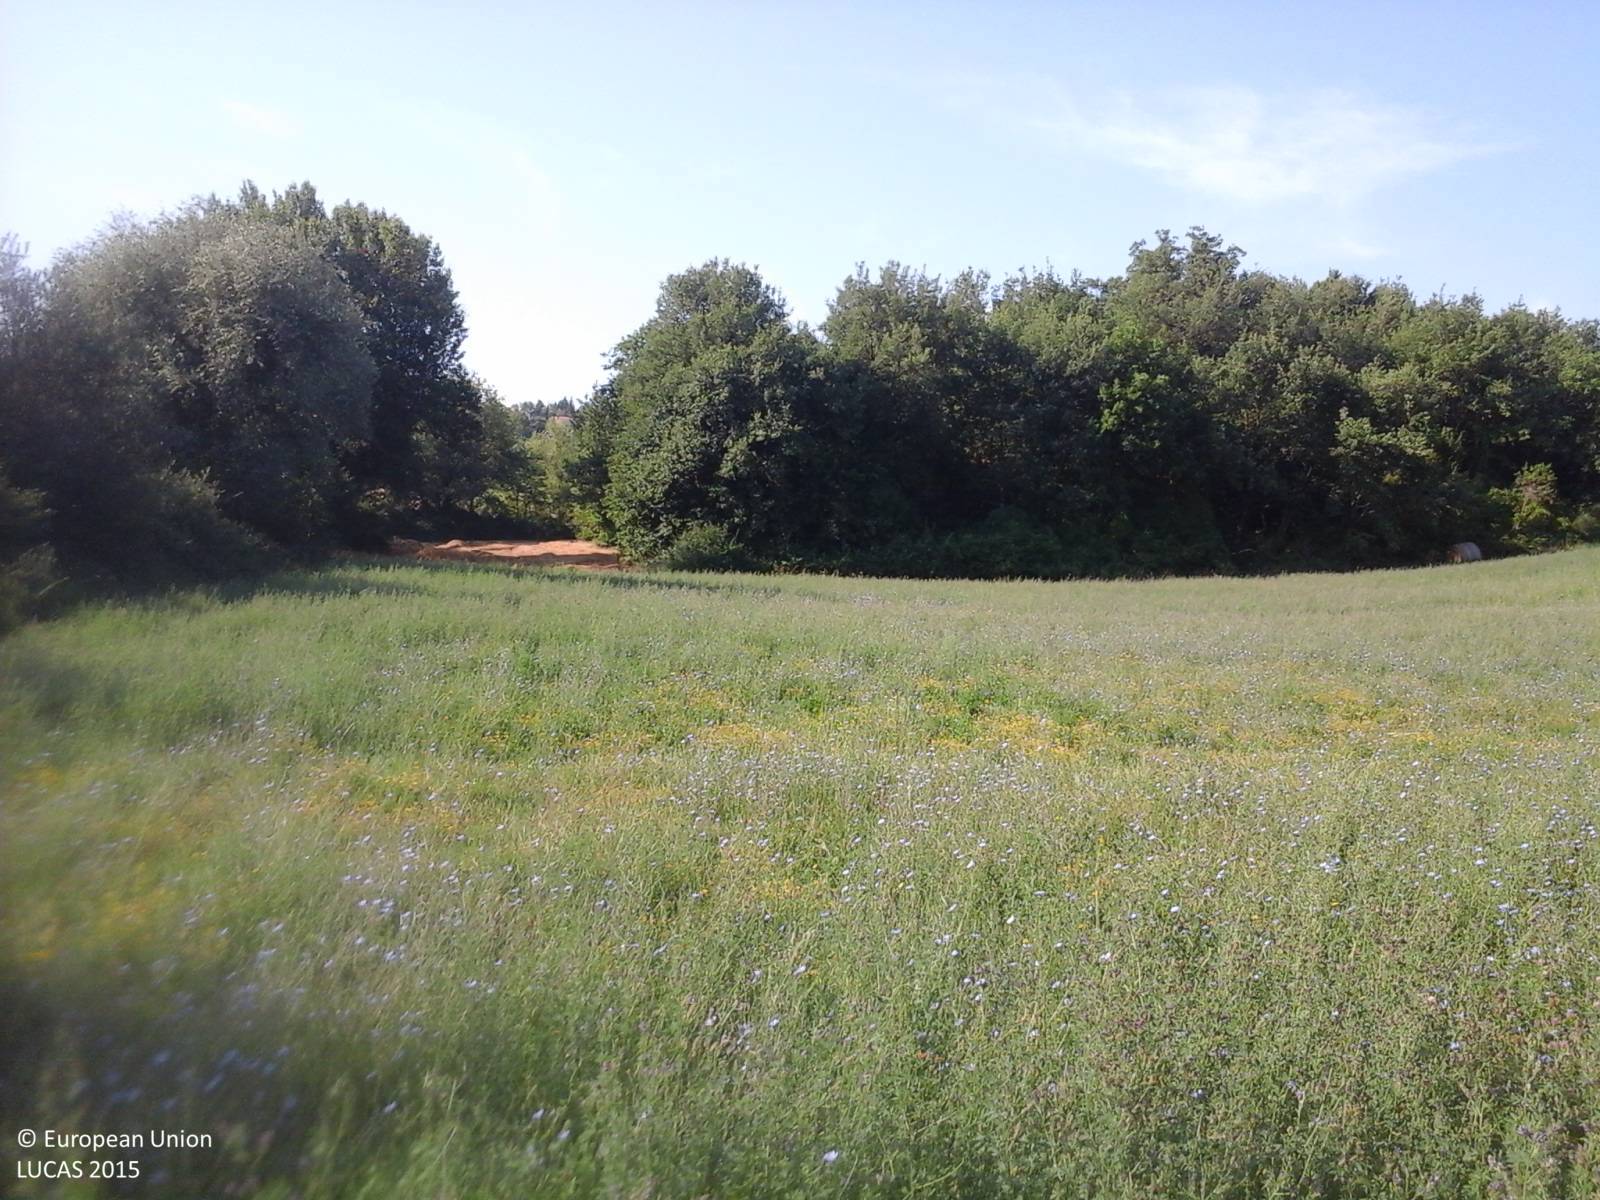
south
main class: Cropland
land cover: Lucerne
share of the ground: > 75 %
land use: Agriculture (excluding fallow land and kitchen gardens)
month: July
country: IT
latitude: 43.0341
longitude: 11.8722
